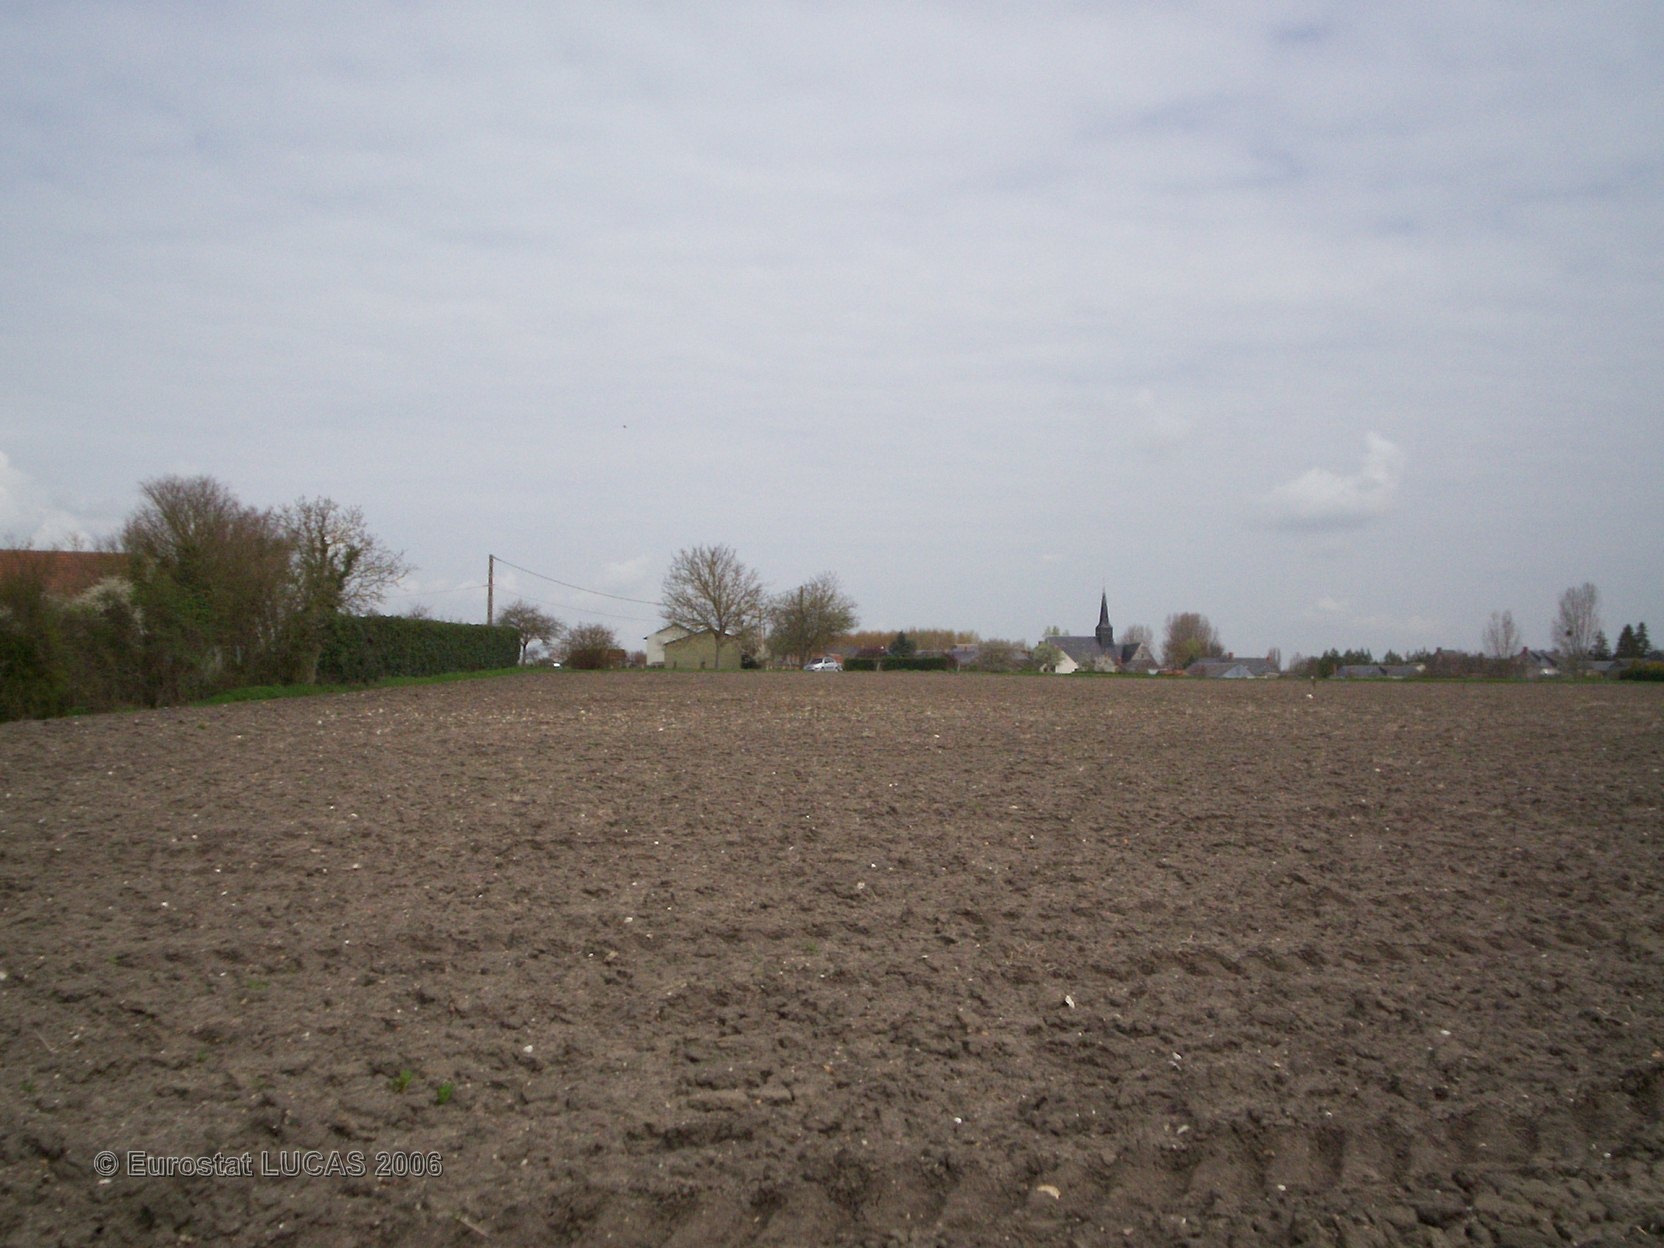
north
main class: Cropland
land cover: Sunflower
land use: Agriculture (excluding fallow land and kitchen gardens)
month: May
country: FR
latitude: 47.5261
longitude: 0.1334
